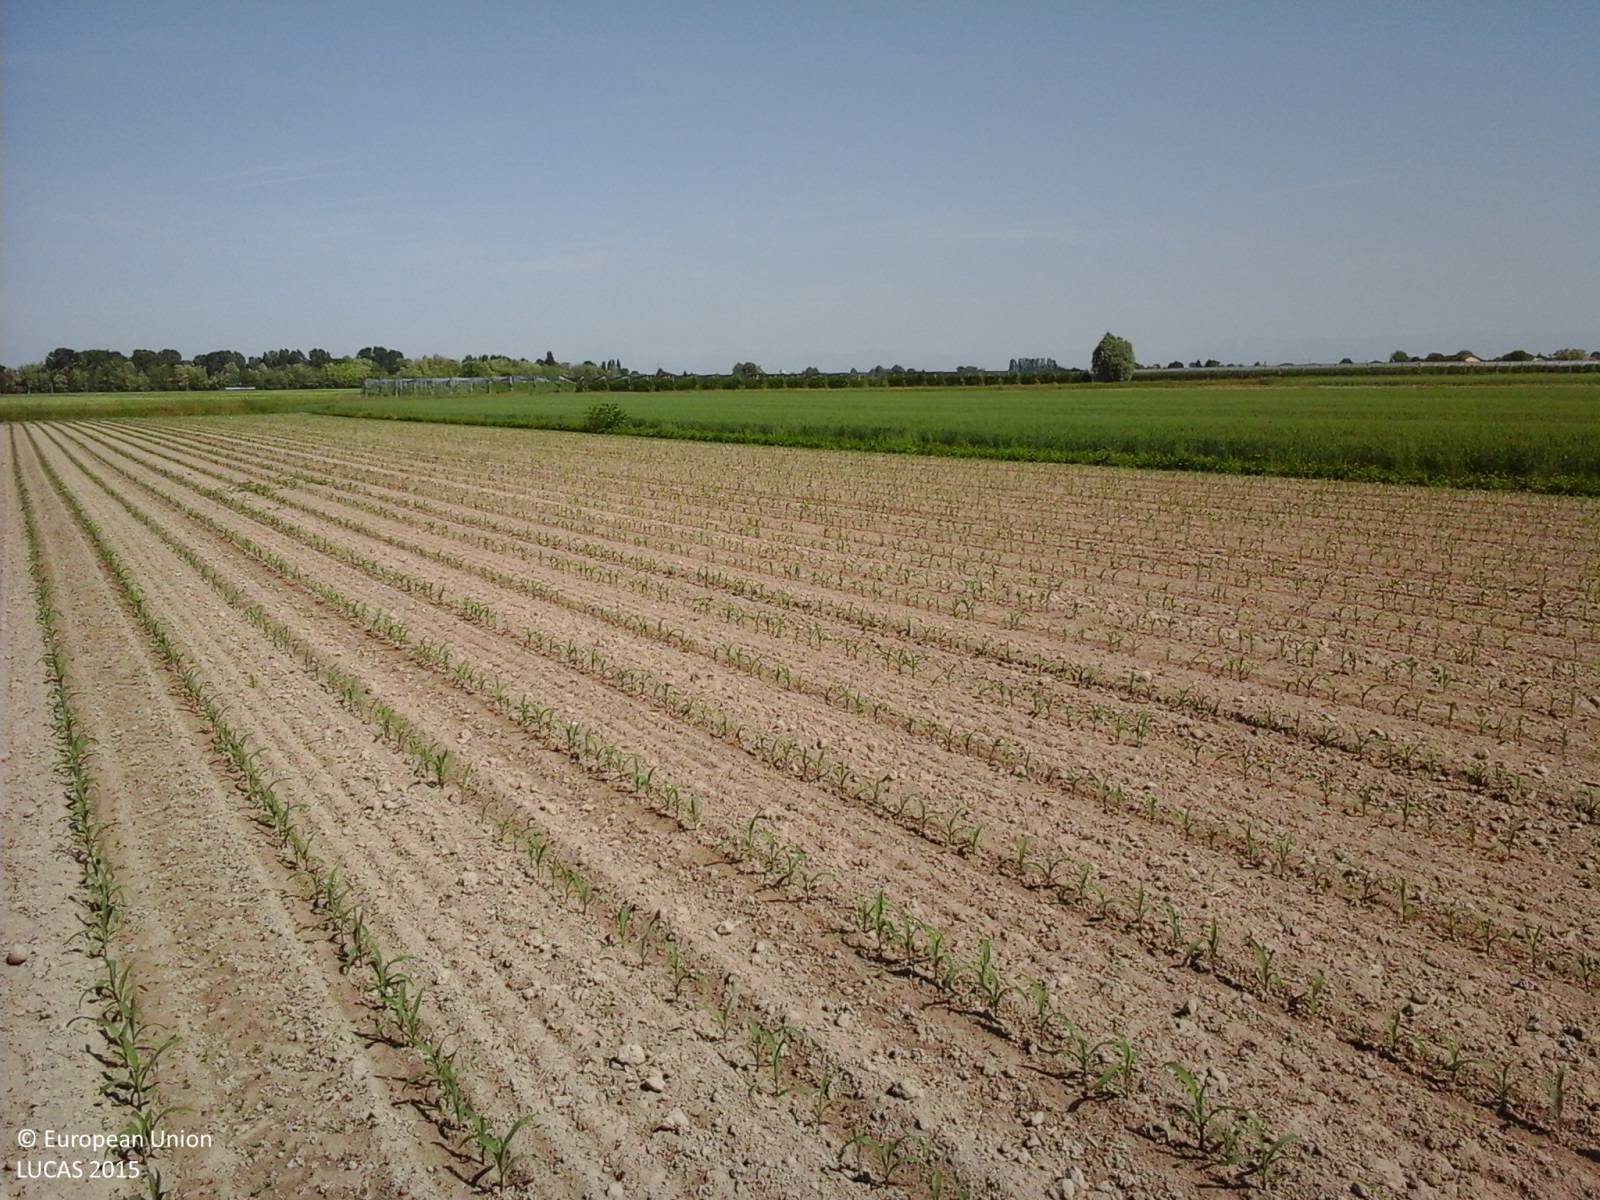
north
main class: Cropland
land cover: Maize
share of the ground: < 10 %
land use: Agriculture (excluding fallow land and kitchen gardens)
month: May
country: IT
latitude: 45.7498
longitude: 13.0169
